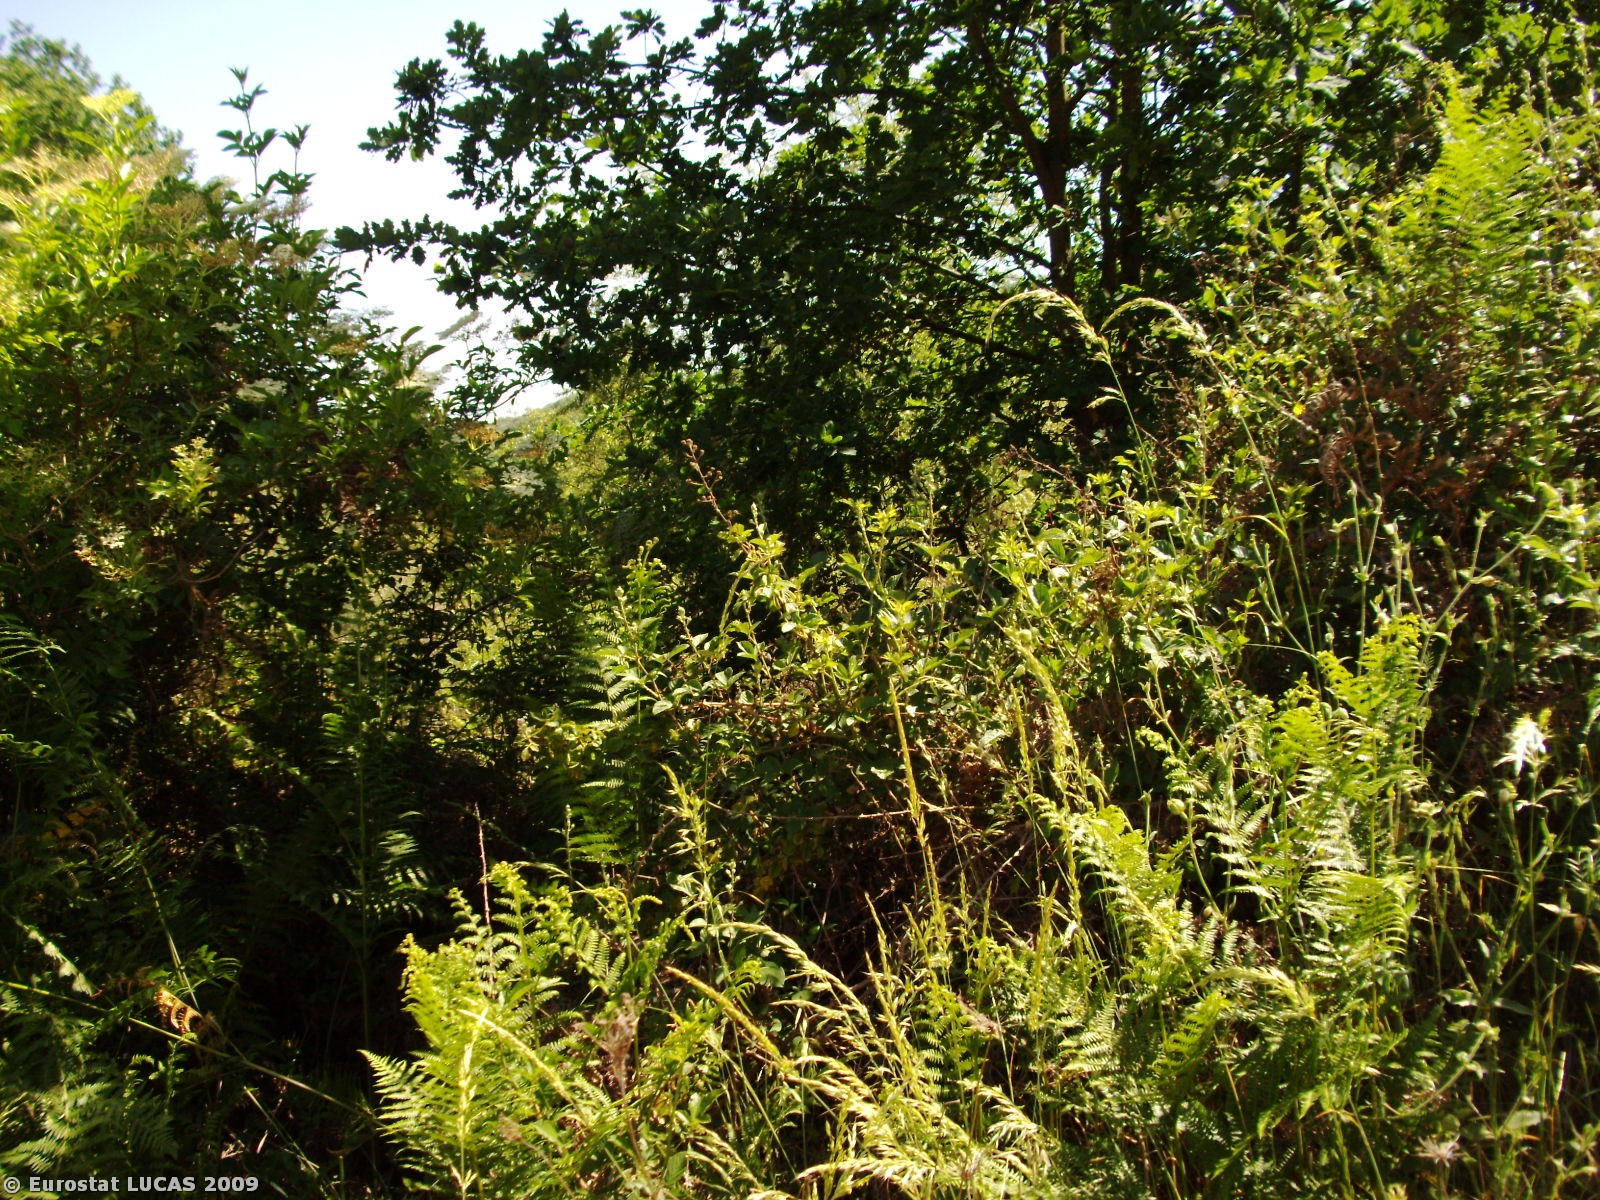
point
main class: Shrubland
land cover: Shrubland with sparse tree cover
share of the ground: > 75 %
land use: Unused
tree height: > 5 m
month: June
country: PT
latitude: 40.6224
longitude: -7.4780
